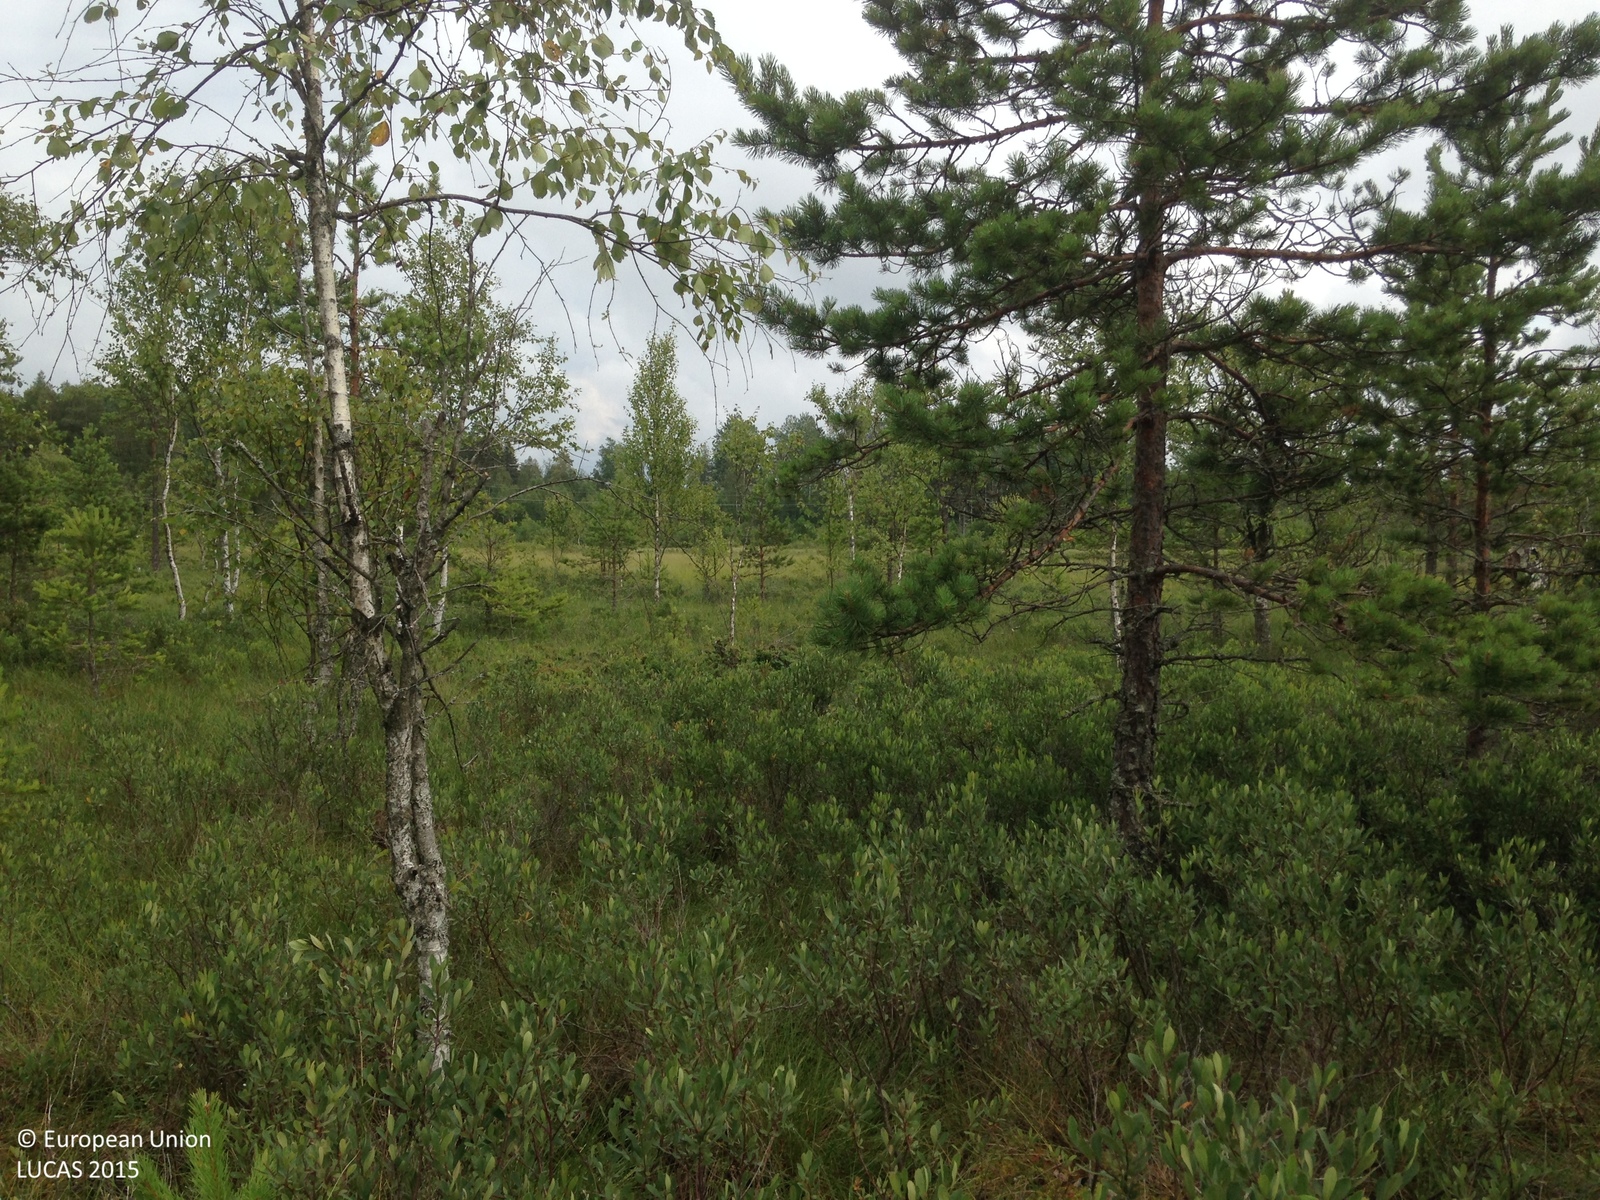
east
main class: Woodland
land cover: Pine dominated mixed woodland
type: boreal forest
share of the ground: 25 - 50 %
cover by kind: lichens and mosses 30 %, shrubs 25 %, coniferous forest trees 20 %, broadleaved forest trees 15 %, herbaceous plants 10 %
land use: Semi-natural and natural areas not in use
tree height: < 5 m
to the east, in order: Pine dominated mixed woodland; Inland marshes; Broadleaved woodland; Ditches and canals; Groves; Railways; Grass margins; Ditches and canals; Broadleaved woodland; Tracks; Broadleaved woodland
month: July
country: SE
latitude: 59.0584
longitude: 14.6478
